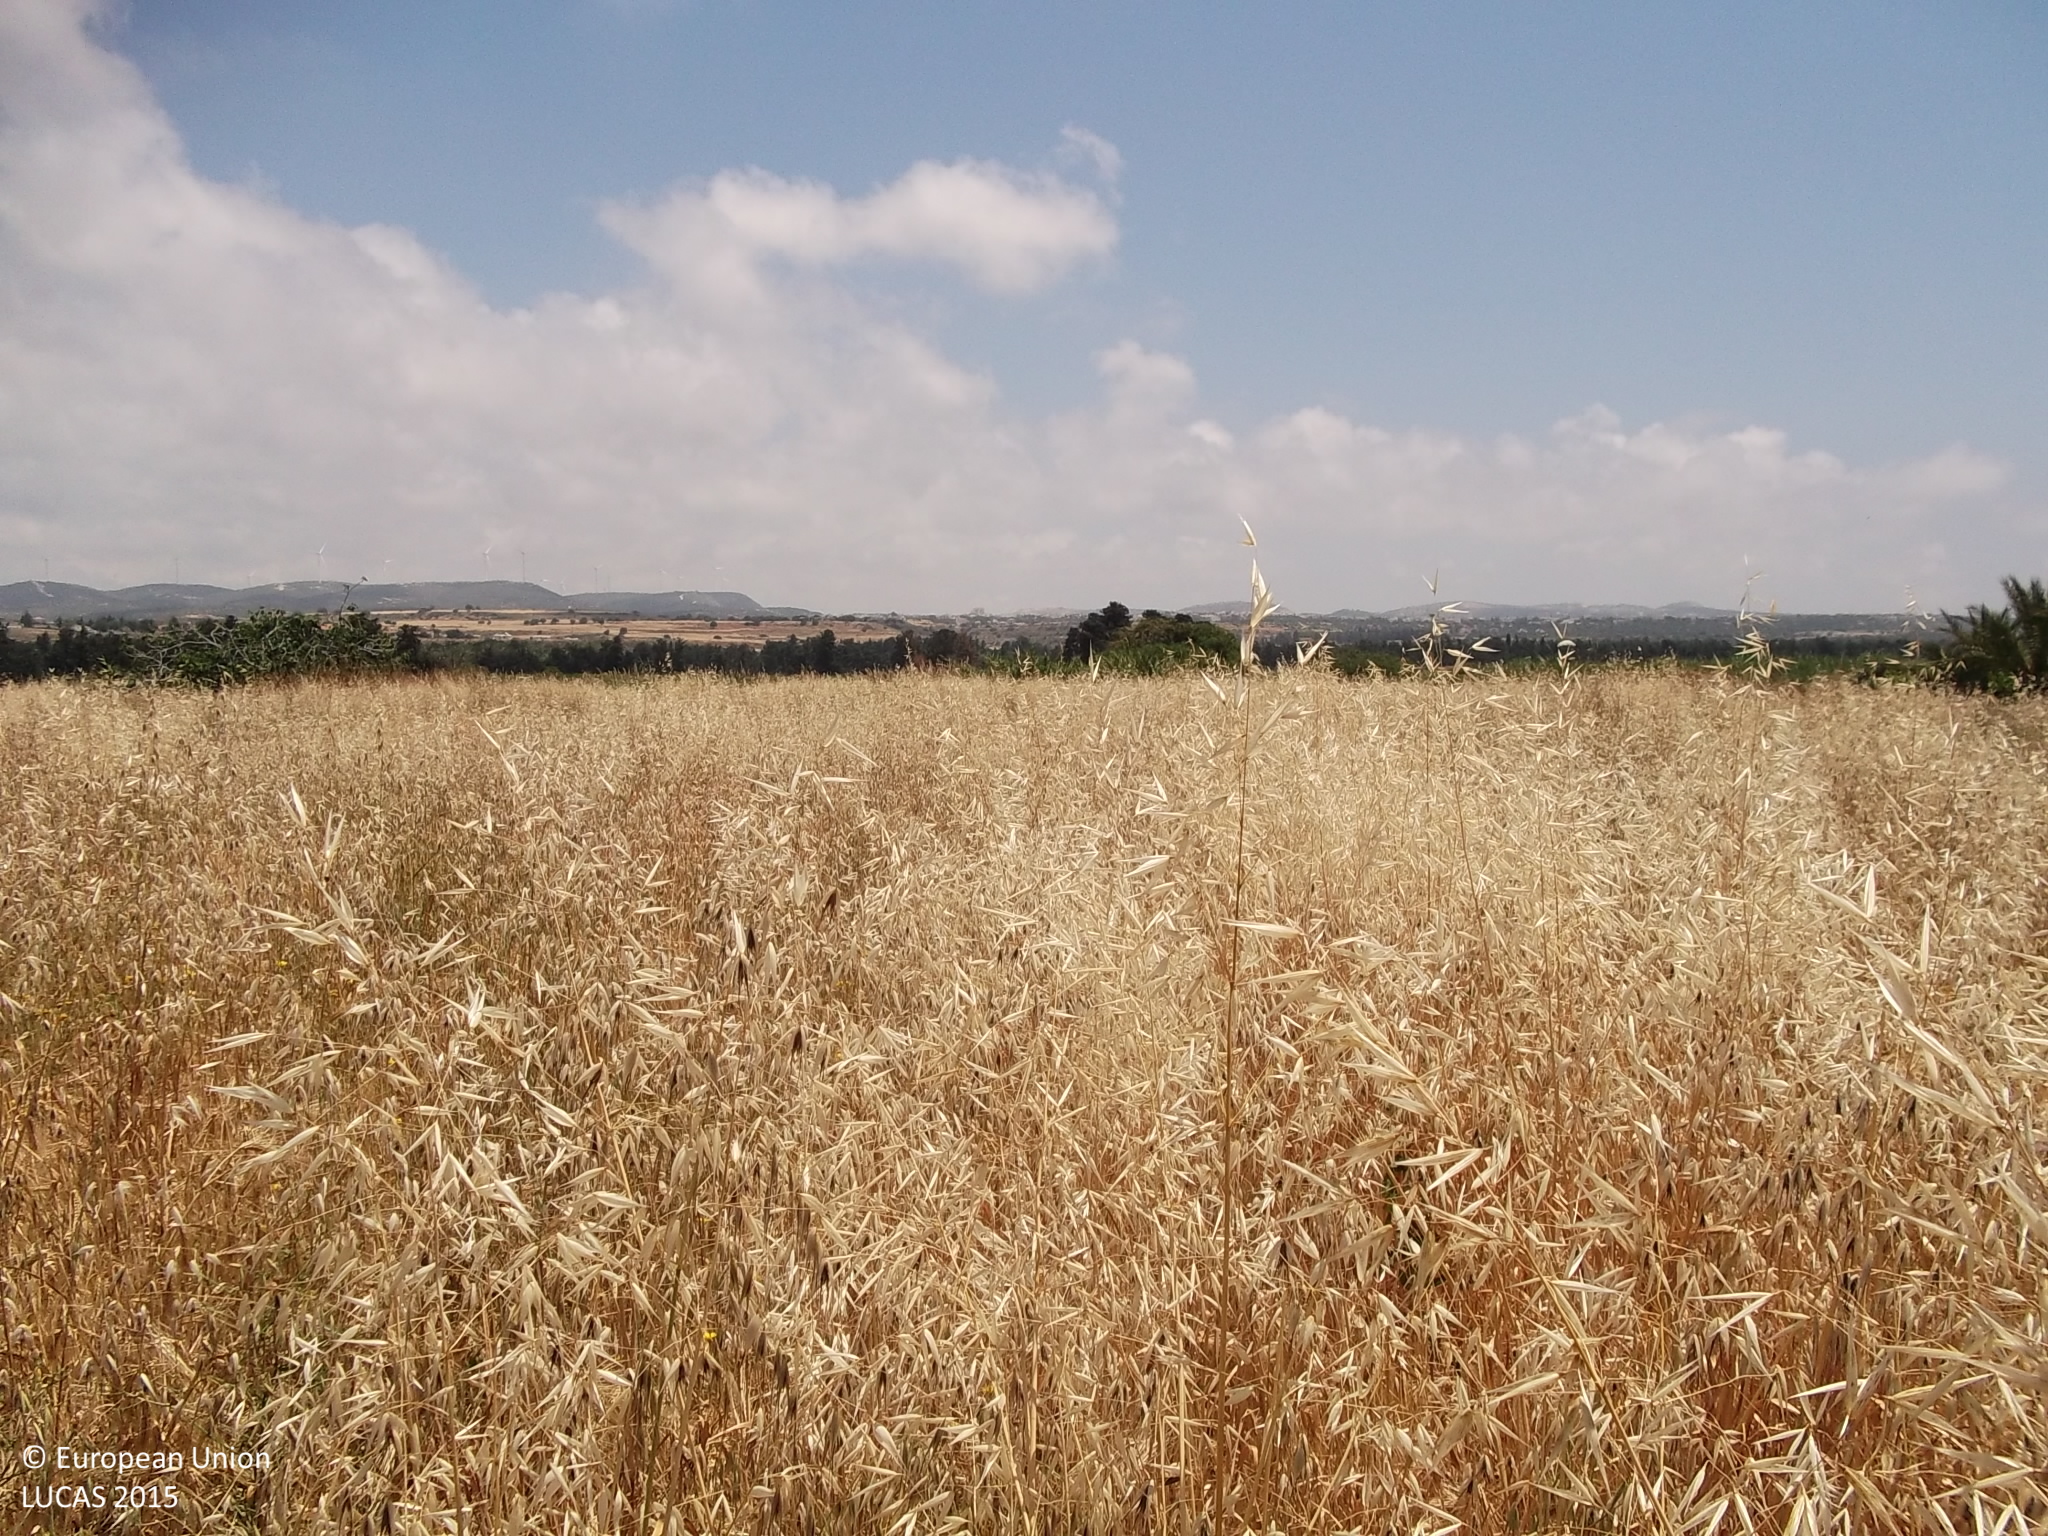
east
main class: Cropland
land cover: Mixed cereals for fodder
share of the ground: > 75 %
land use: Agriculture (excluding fallow land and kitchen gardens)
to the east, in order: Mixed cereals for fodder; Tracks; Mixed cereals for fodder; Grass margins; Shrubland with sparse tree cover; Rock outcrops
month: May
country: CY
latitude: 34.6993
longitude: 32.5597
